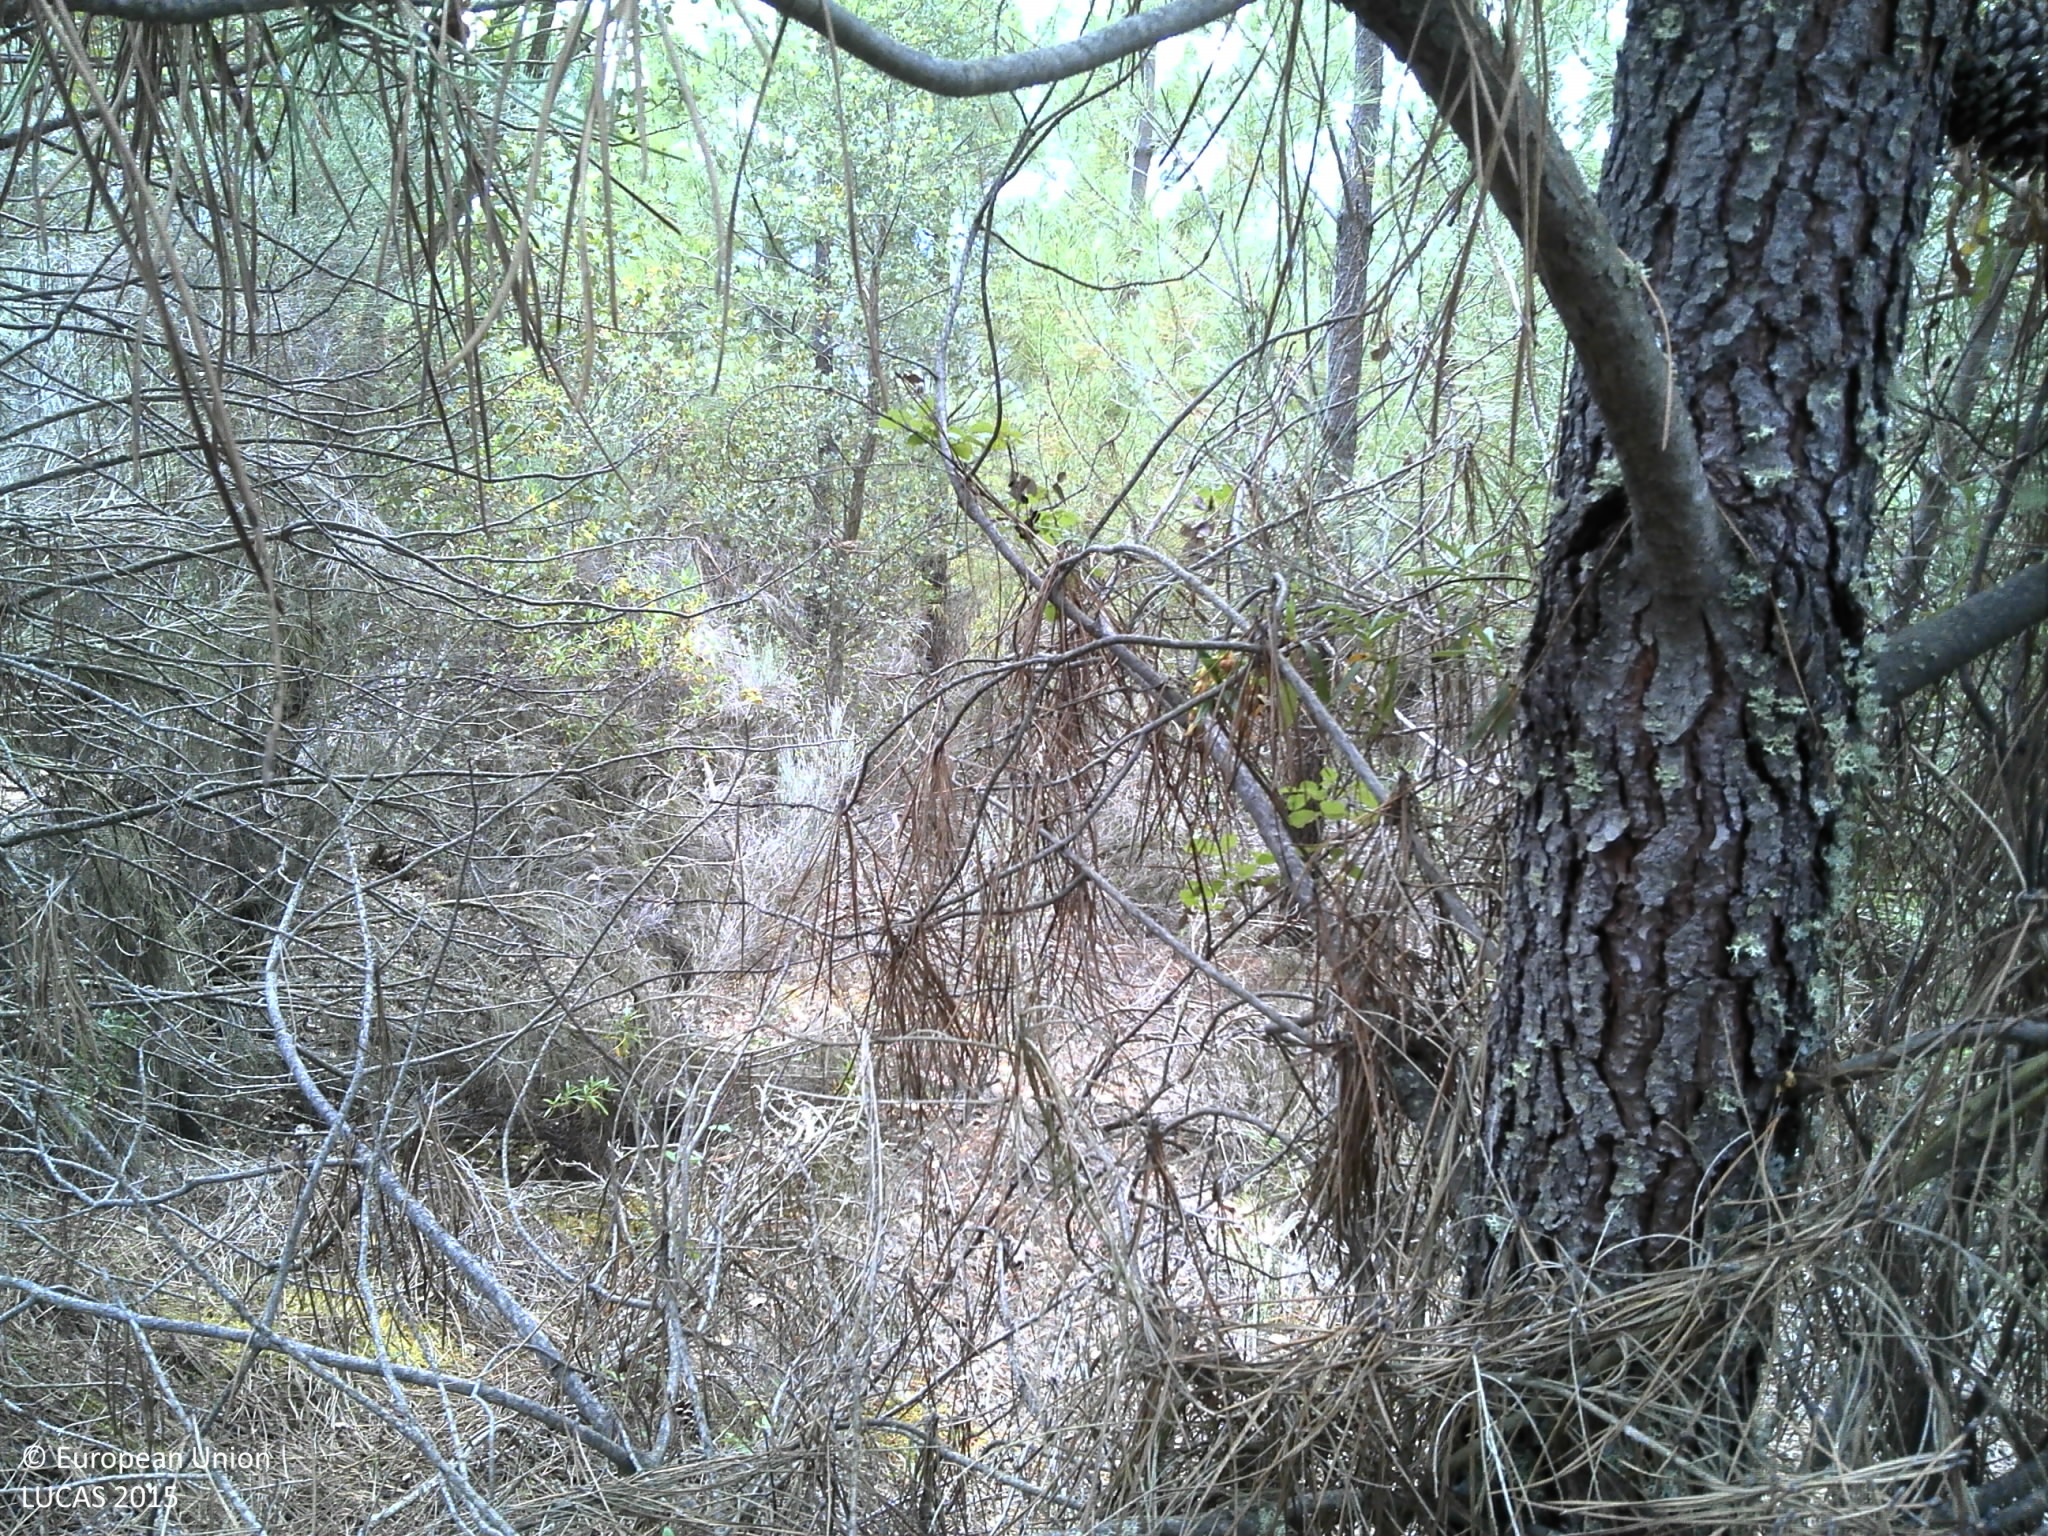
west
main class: Woodland
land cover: Pine dominated coniferous woodland
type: coniferous forest of the mediterranean region
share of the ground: 25 - 50 %
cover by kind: shrubs 55 %, coniferous forest trees 25 %, unconsolidated bare surface 20 %
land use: Forestry
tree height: > 5 m
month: June
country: PT
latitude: 41.2638
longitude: -6.9762
